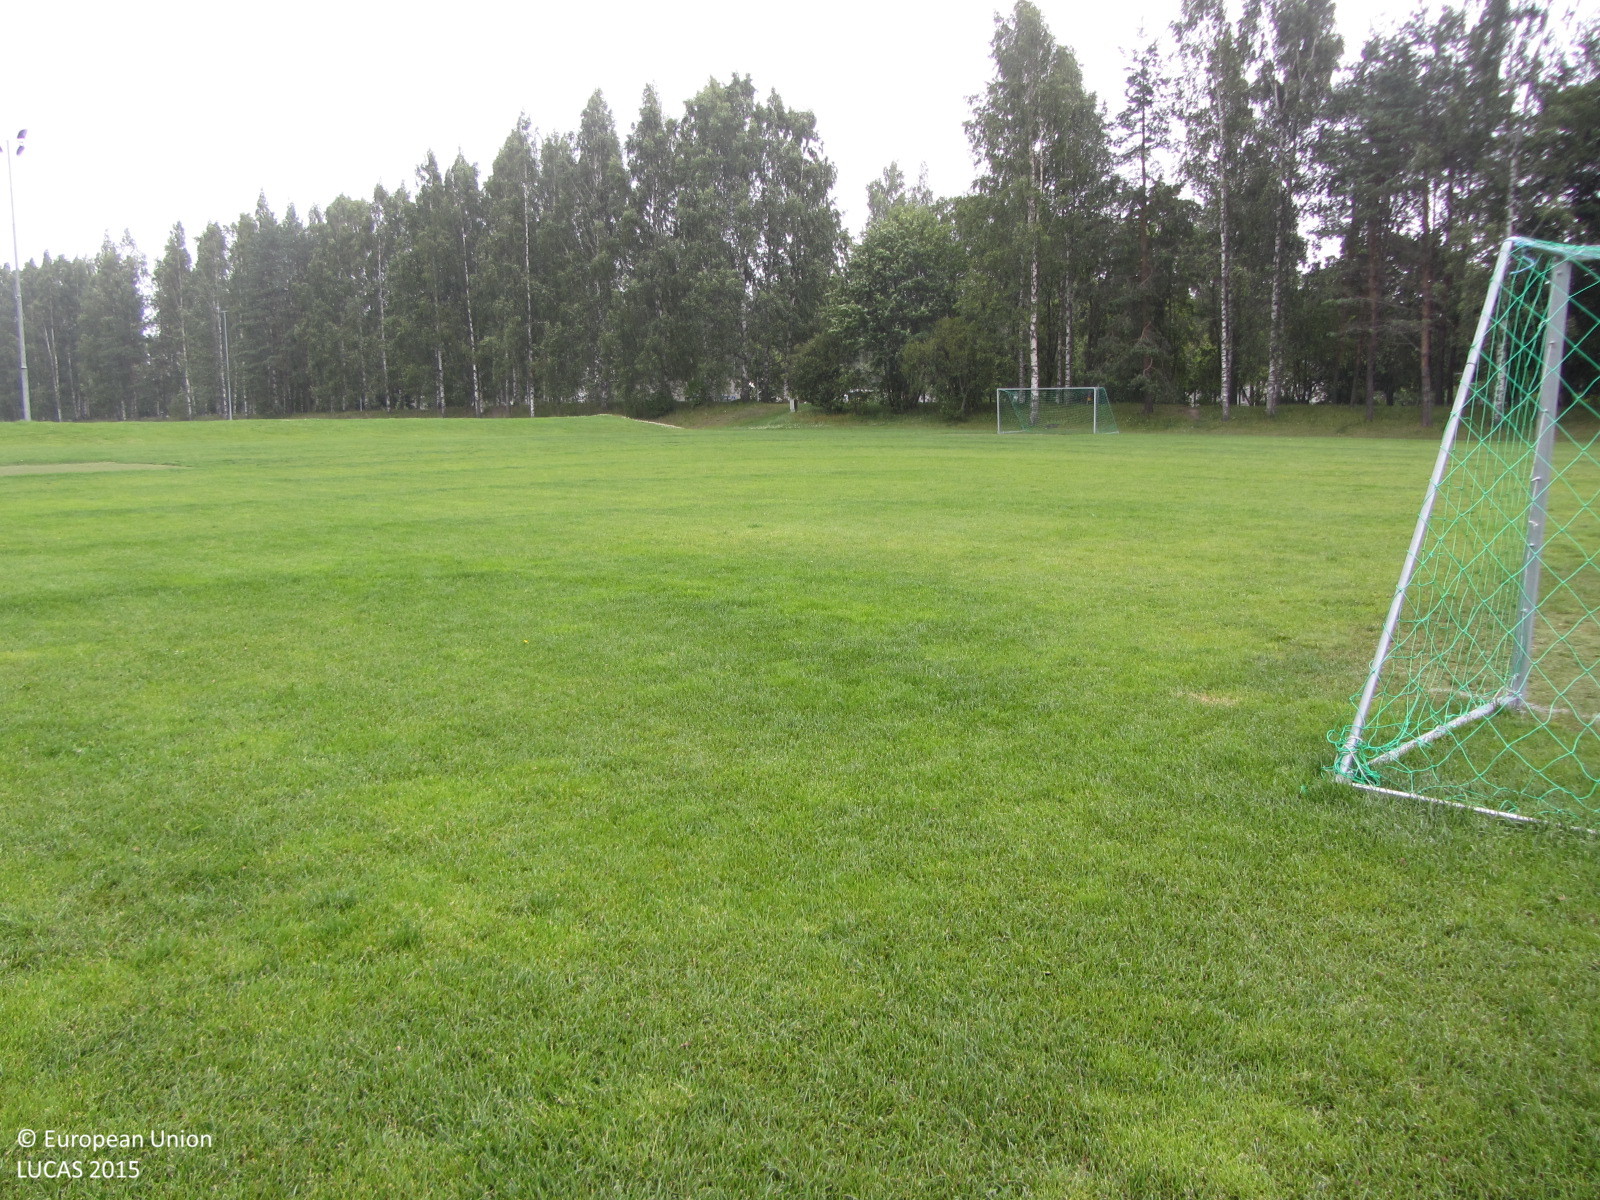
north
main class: Grassland
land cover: Grassland without tree/shrub cover
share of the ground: > 75 %
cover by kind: herbaceous plants 100 %
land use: Sport
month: July
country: FI
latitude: 60.6395
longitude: 24.8312
